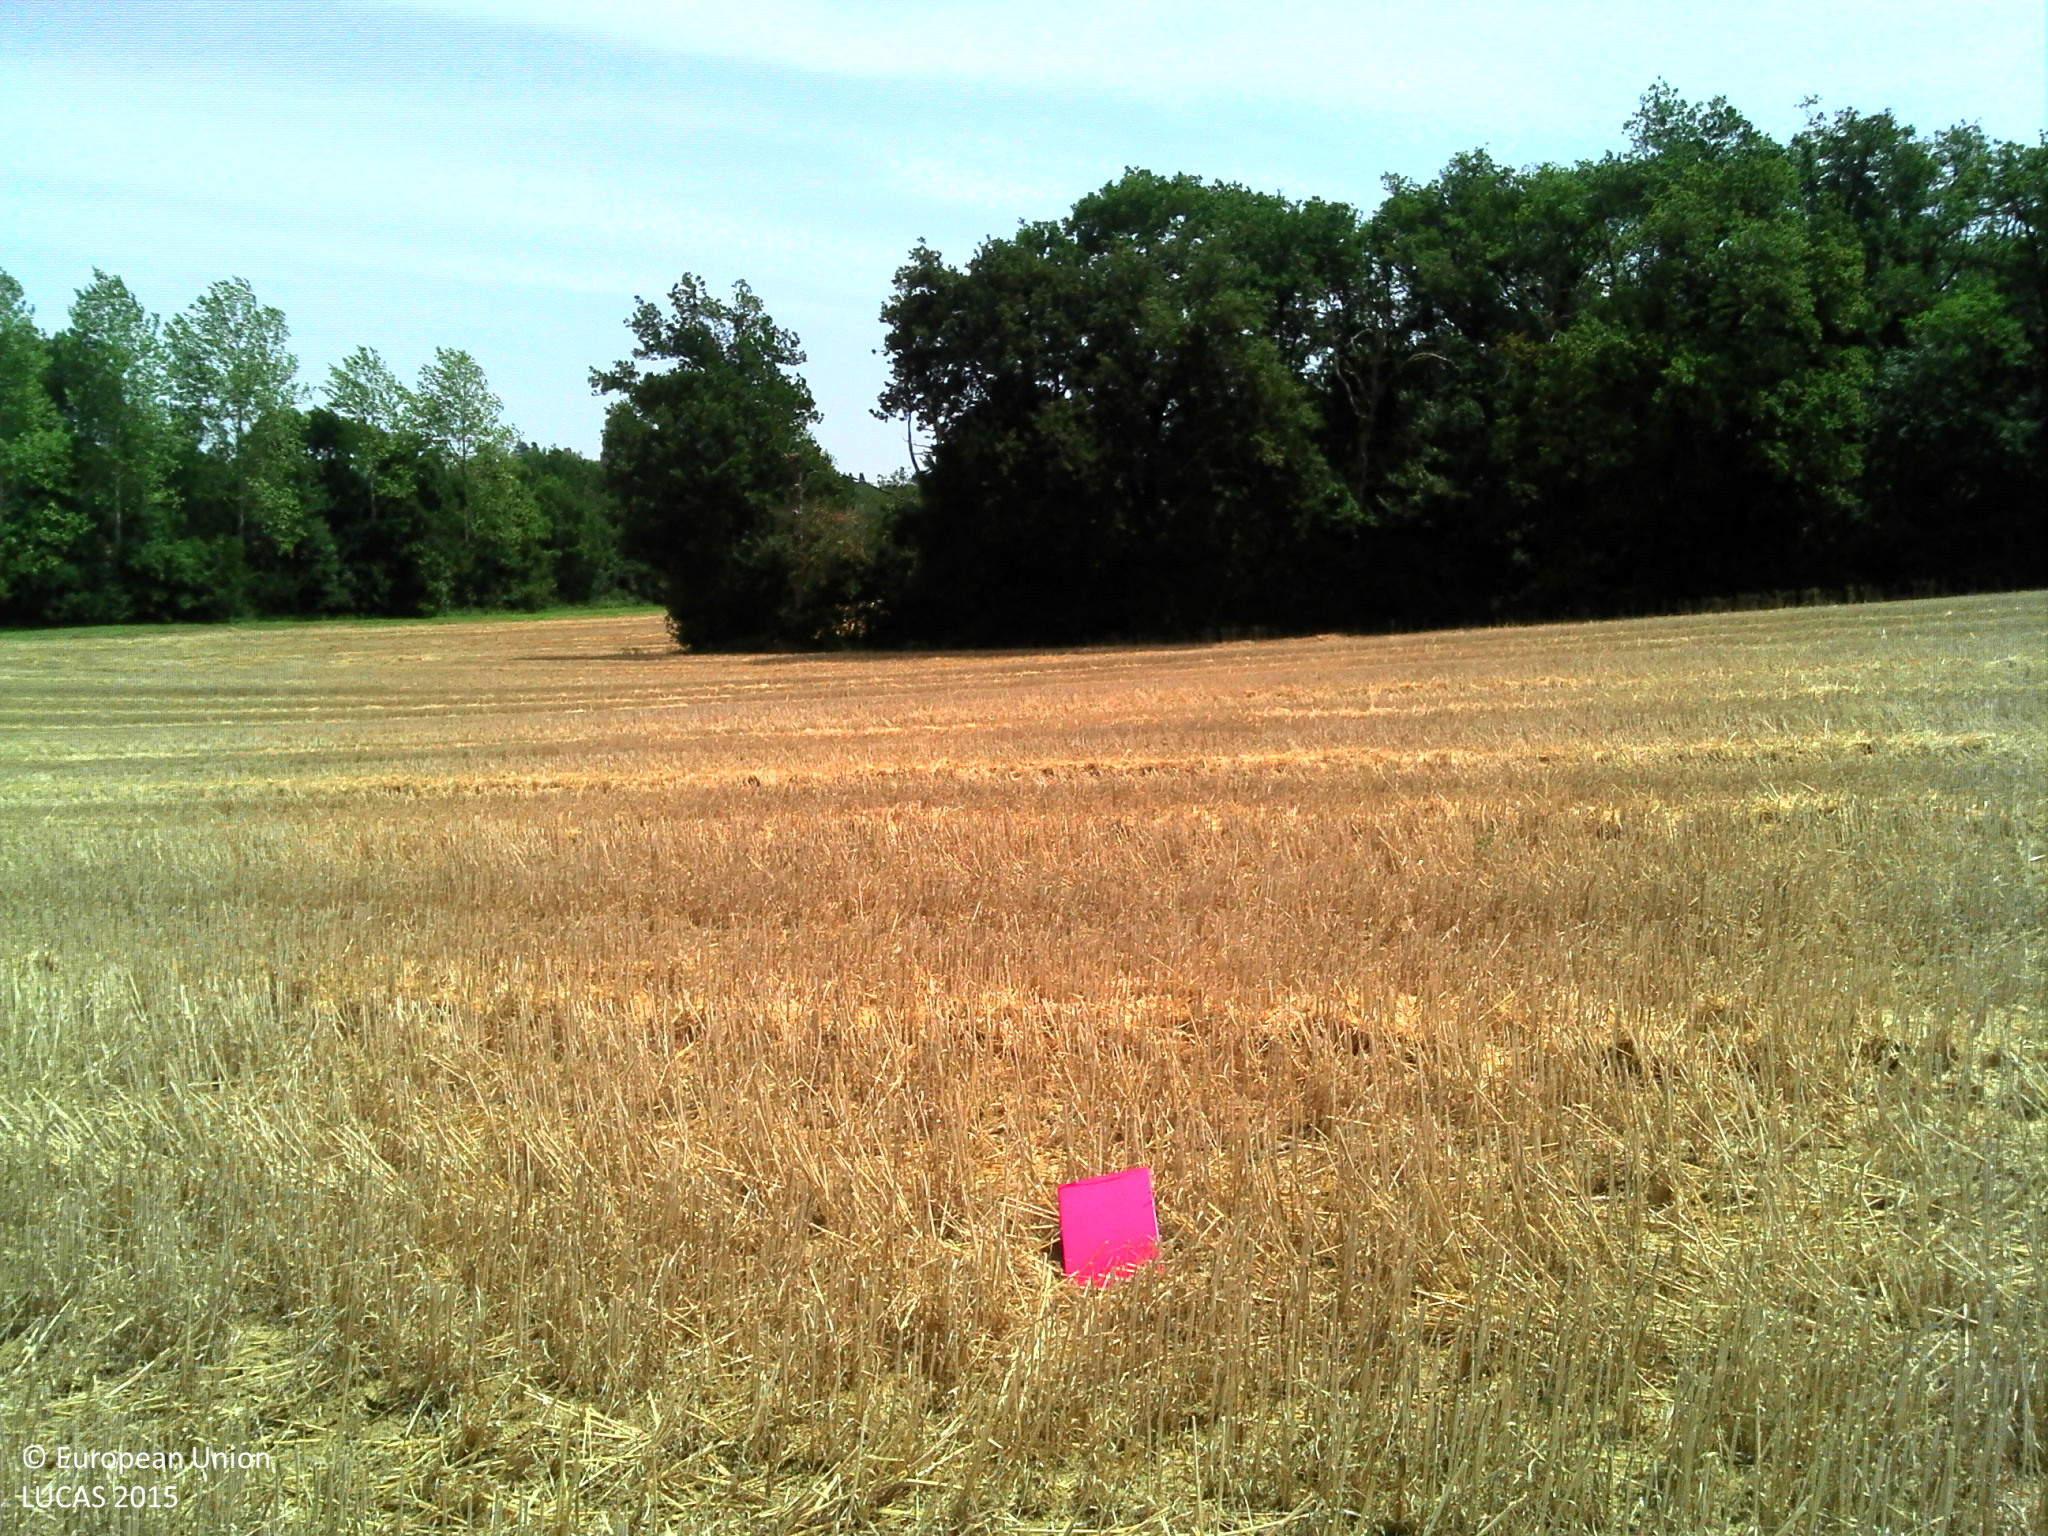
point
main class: Cropland
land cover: Durum wheat
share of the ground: > 75 %
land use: Agriculture (excluding fallow land and kitchen gardens)
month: July
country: FR
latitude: 43.5640
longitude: 1.0497
